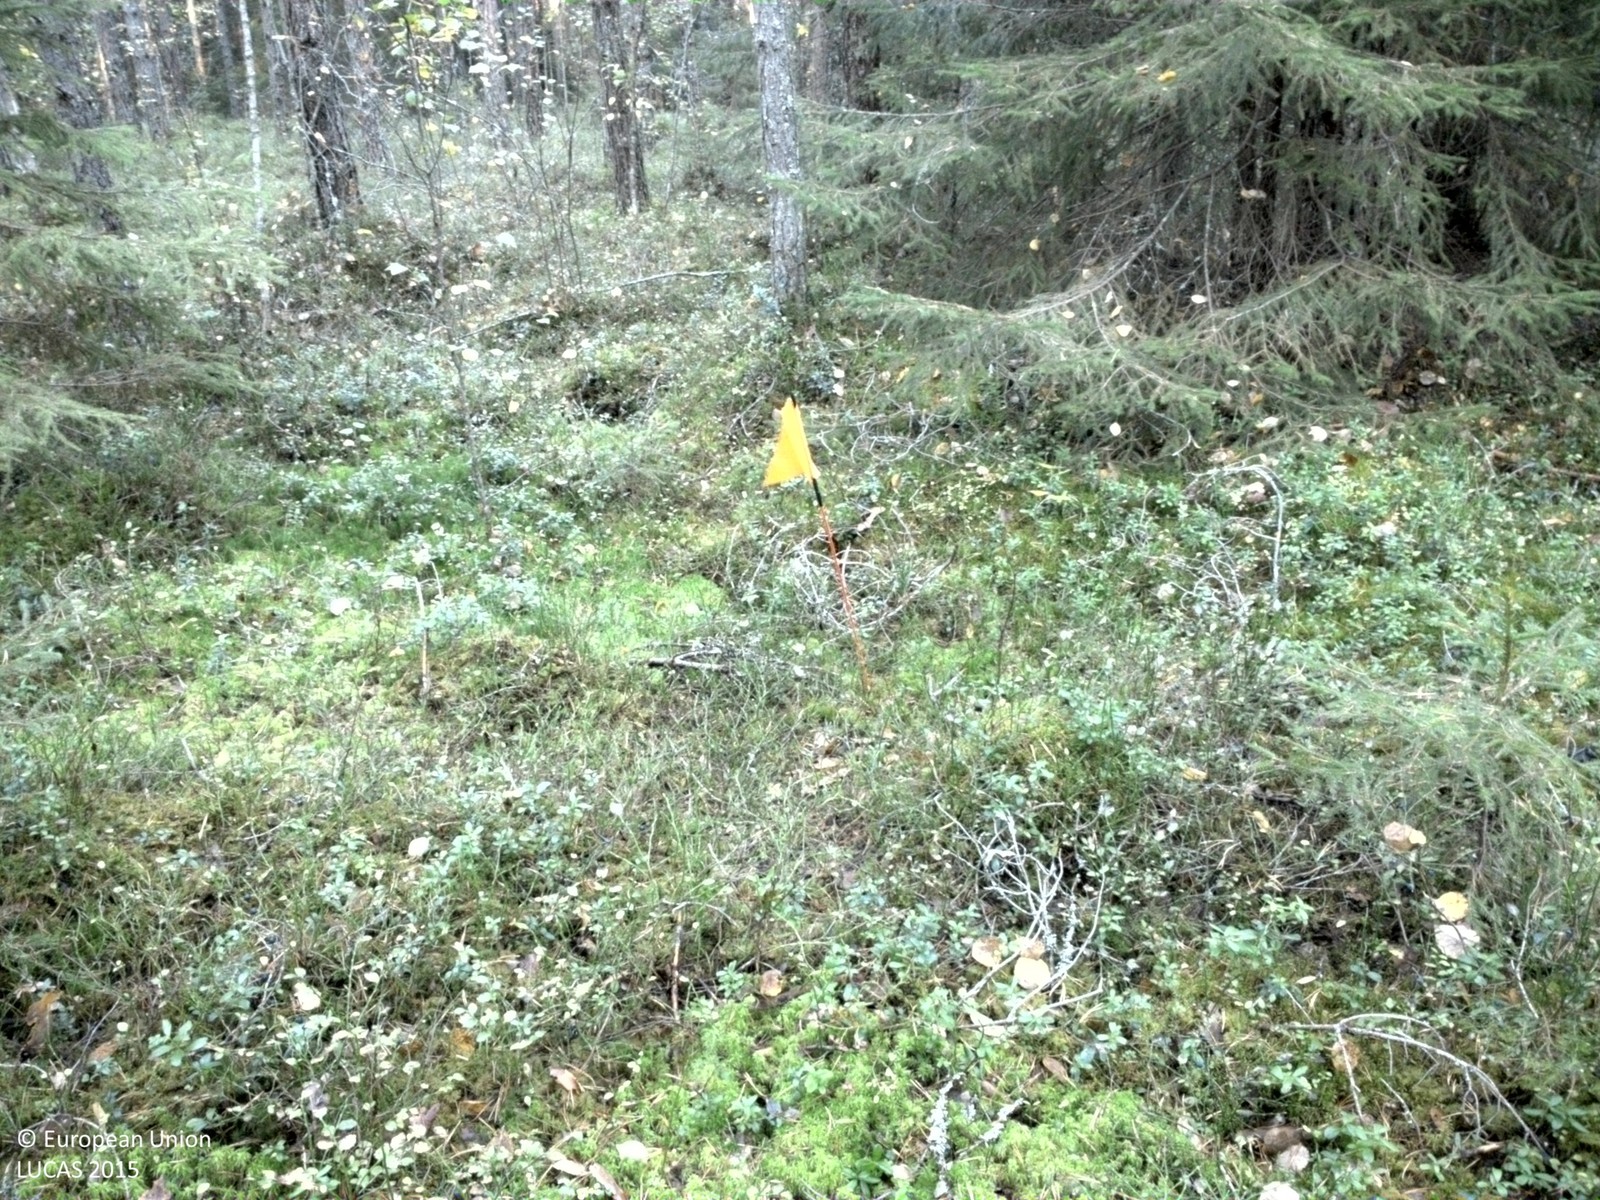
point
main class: Woodland
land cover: Pine dominated coniferous woodland
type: boreal forest
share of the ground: > 75 %
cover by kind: coniferous forest trees 70 %, broadleaved forest trees 15 %, lichens and mosses 15 %
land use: Forestry
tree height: > 5 m
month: September
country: SE
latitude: 59.9931
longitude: 16.5338
